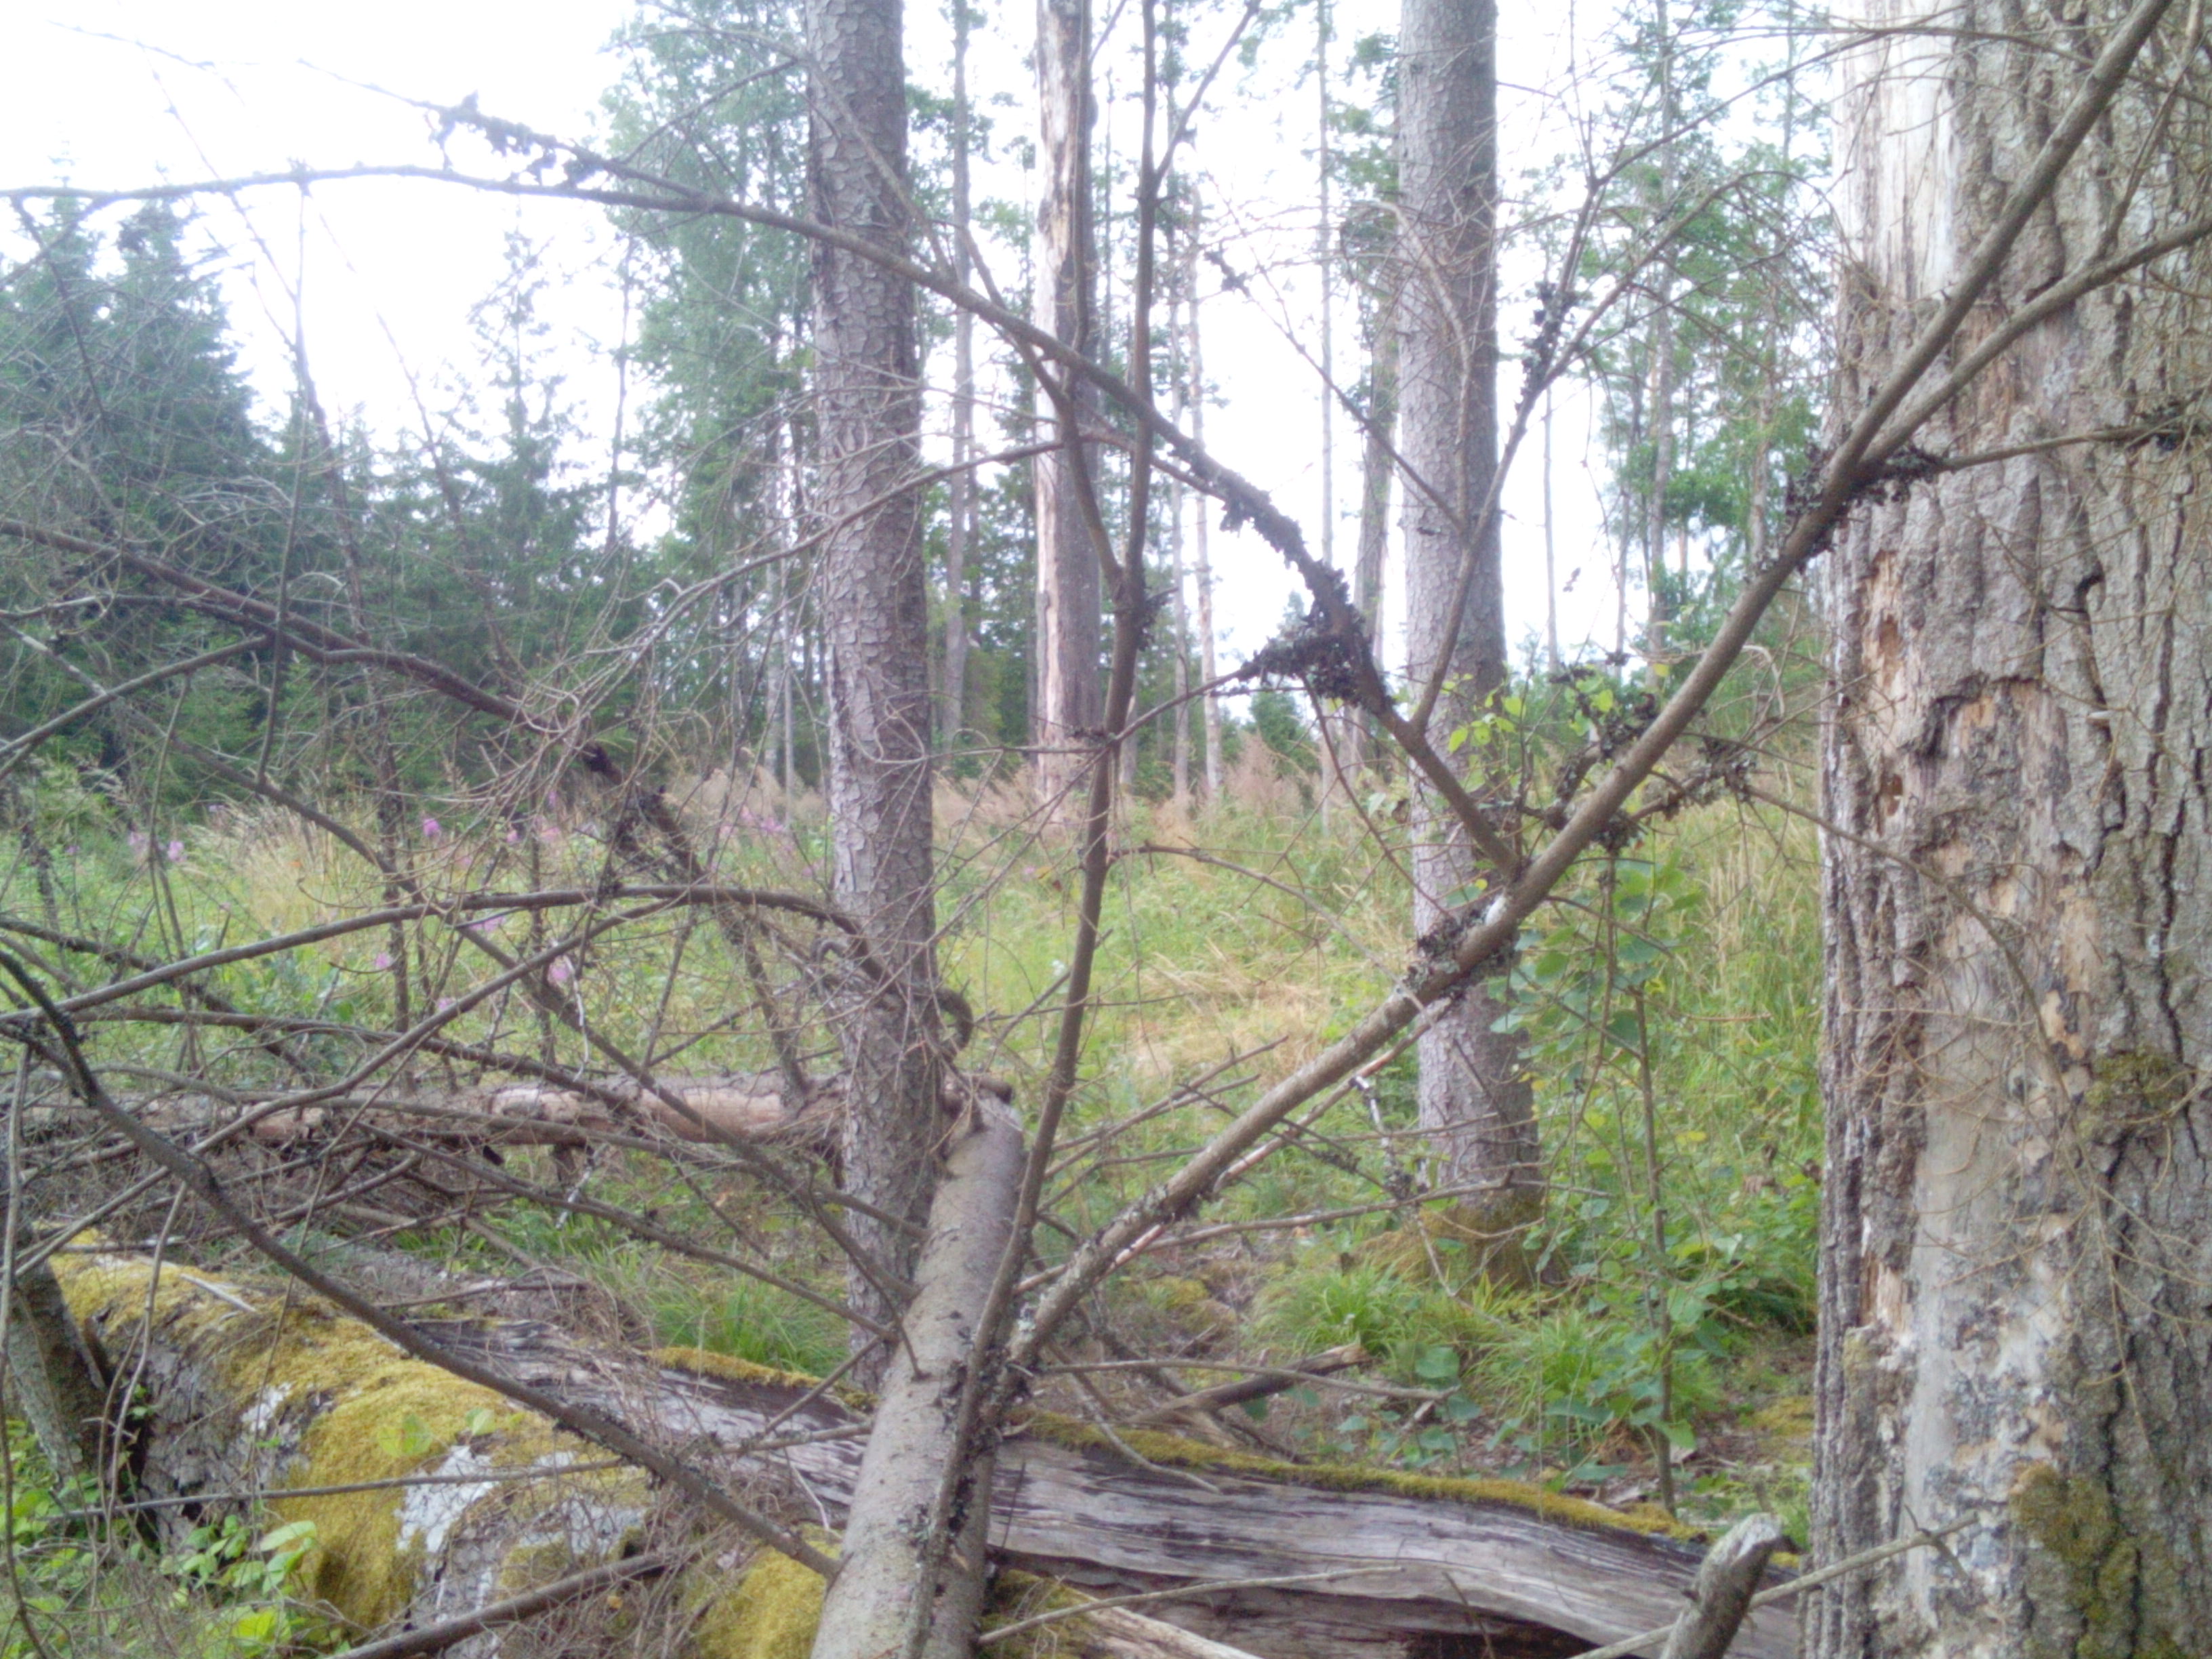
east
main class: Woodland
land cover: Other coniferous woodland
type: hemiboreal forest and nemoral coniferous forest and mixed broadleaved-coniferous forest
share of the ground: 50 - 75 %
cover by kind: coniferous forest trees 70 %, herbaceous plants 15 %, lichens and mosses 10 %
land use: Forestry
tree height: > 5 m
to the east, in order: Other coniferous woodland; Grassland with sparse tree/shrub cover; Spruce dominated mixed woodland; Ponds and wetlands; Spruce dominated mixed woodland; Shrubland with sparse tree cover; Spruce dominated mixed woodland
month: July
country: LV
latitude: 56.8652
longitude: 22.1393
